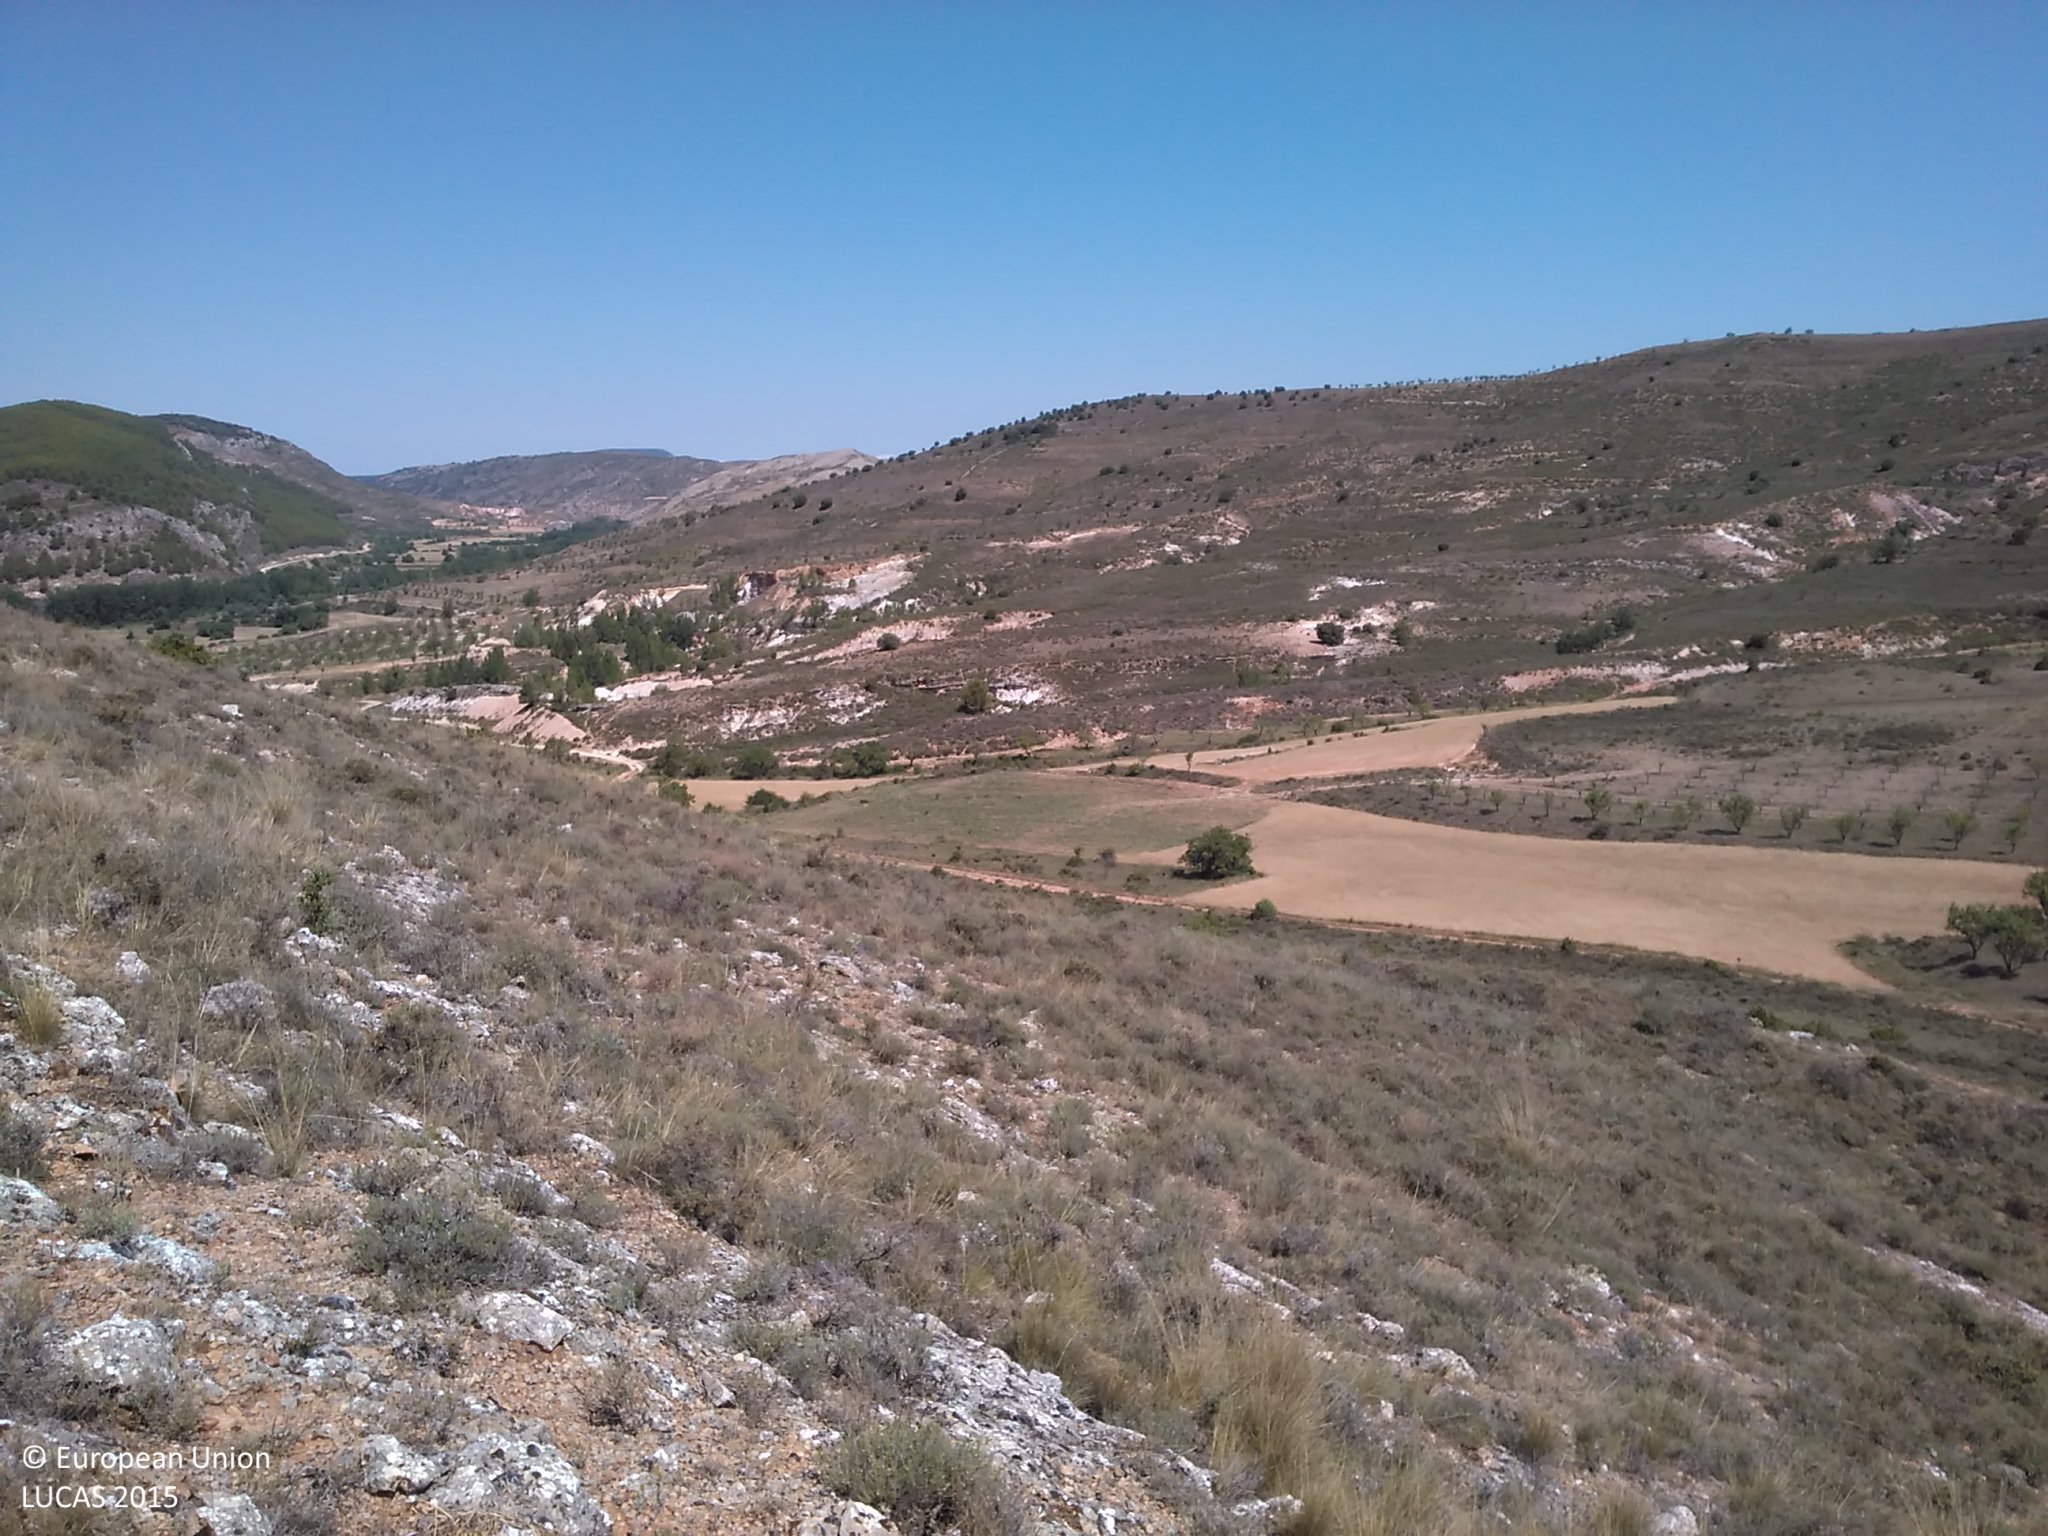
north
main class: Shrubland
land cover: Shrubland without tree cover
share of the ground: 25 - 50 %
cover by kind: shrubs 40 %, consolidated bare surface 25 %, unconsolidated bare surface 25 %, herbaceous plants 5 %, lichens and mosses 5 %
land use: Semi-natural and natural areas not in use
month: July
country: ES
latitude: 41.5117
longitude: -1.9031
